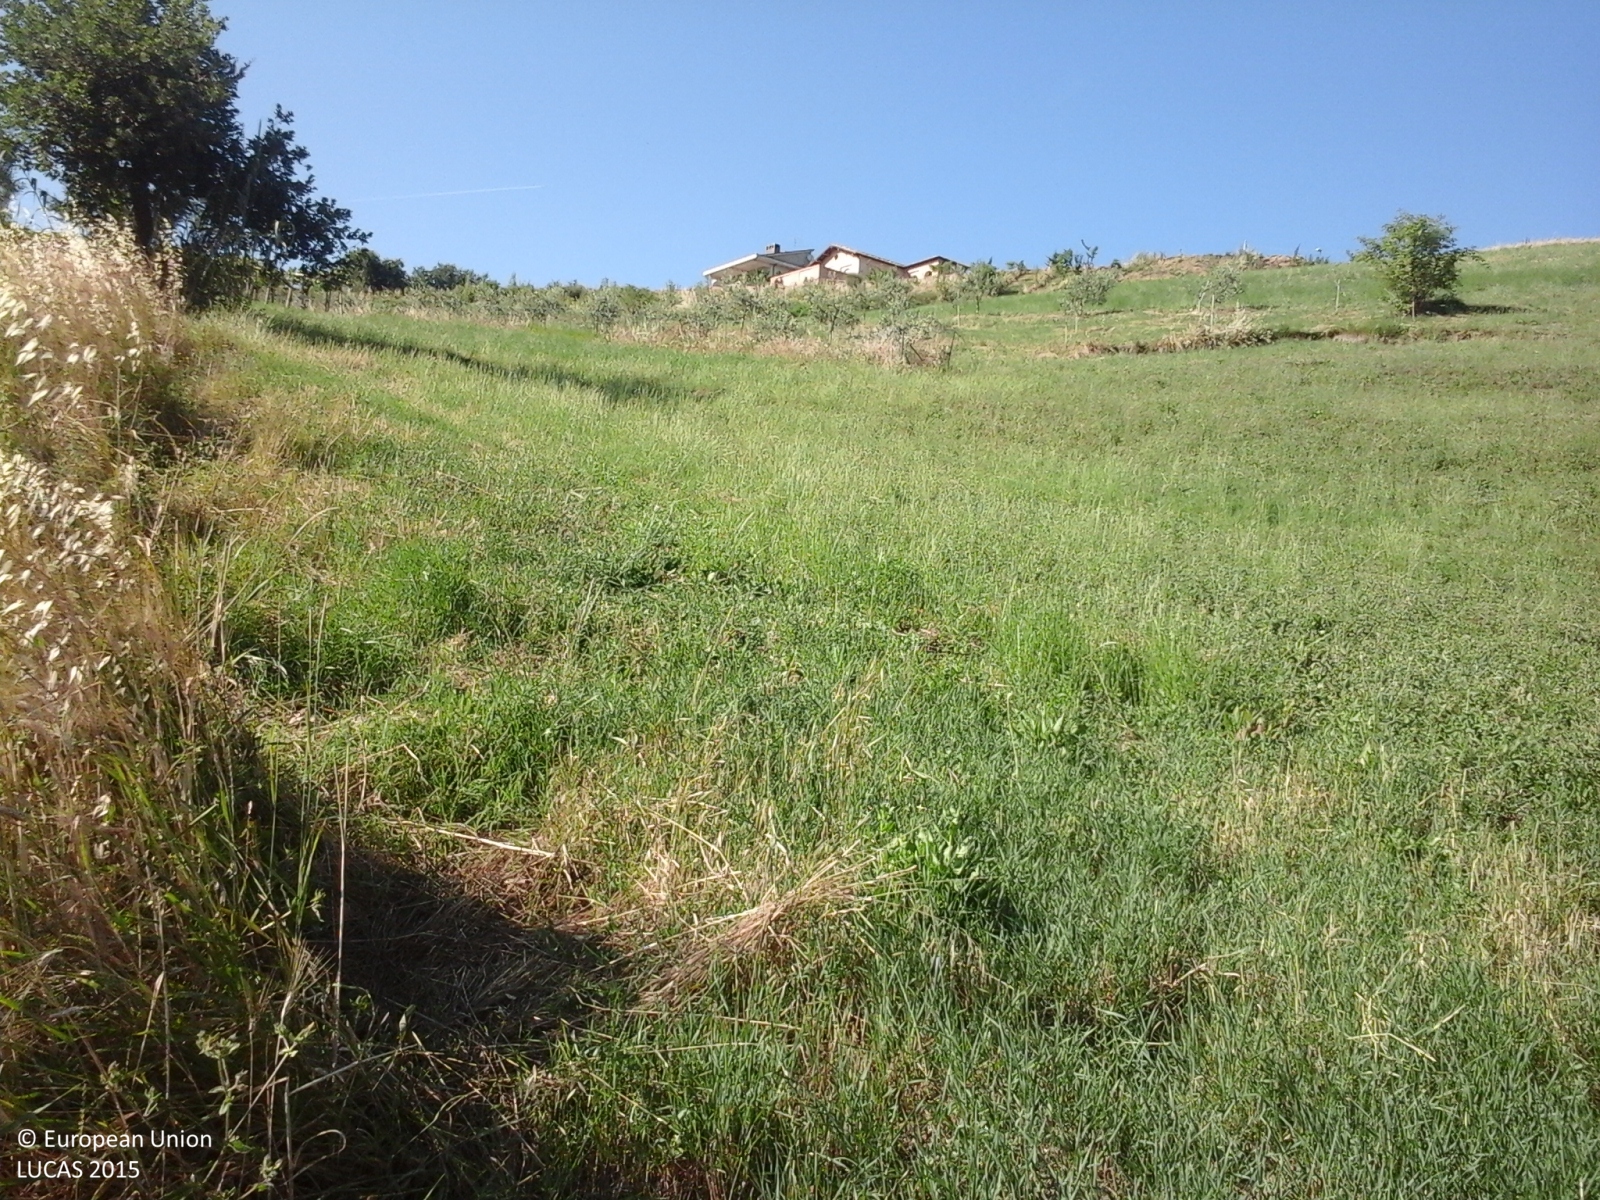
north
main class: Cropland
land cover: Durum wheat
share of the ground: > 75 %
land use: Agriculture (excluding fallow land and kitchen gardens)
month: June
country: IT
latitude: 42.1856
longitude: 14.2366
